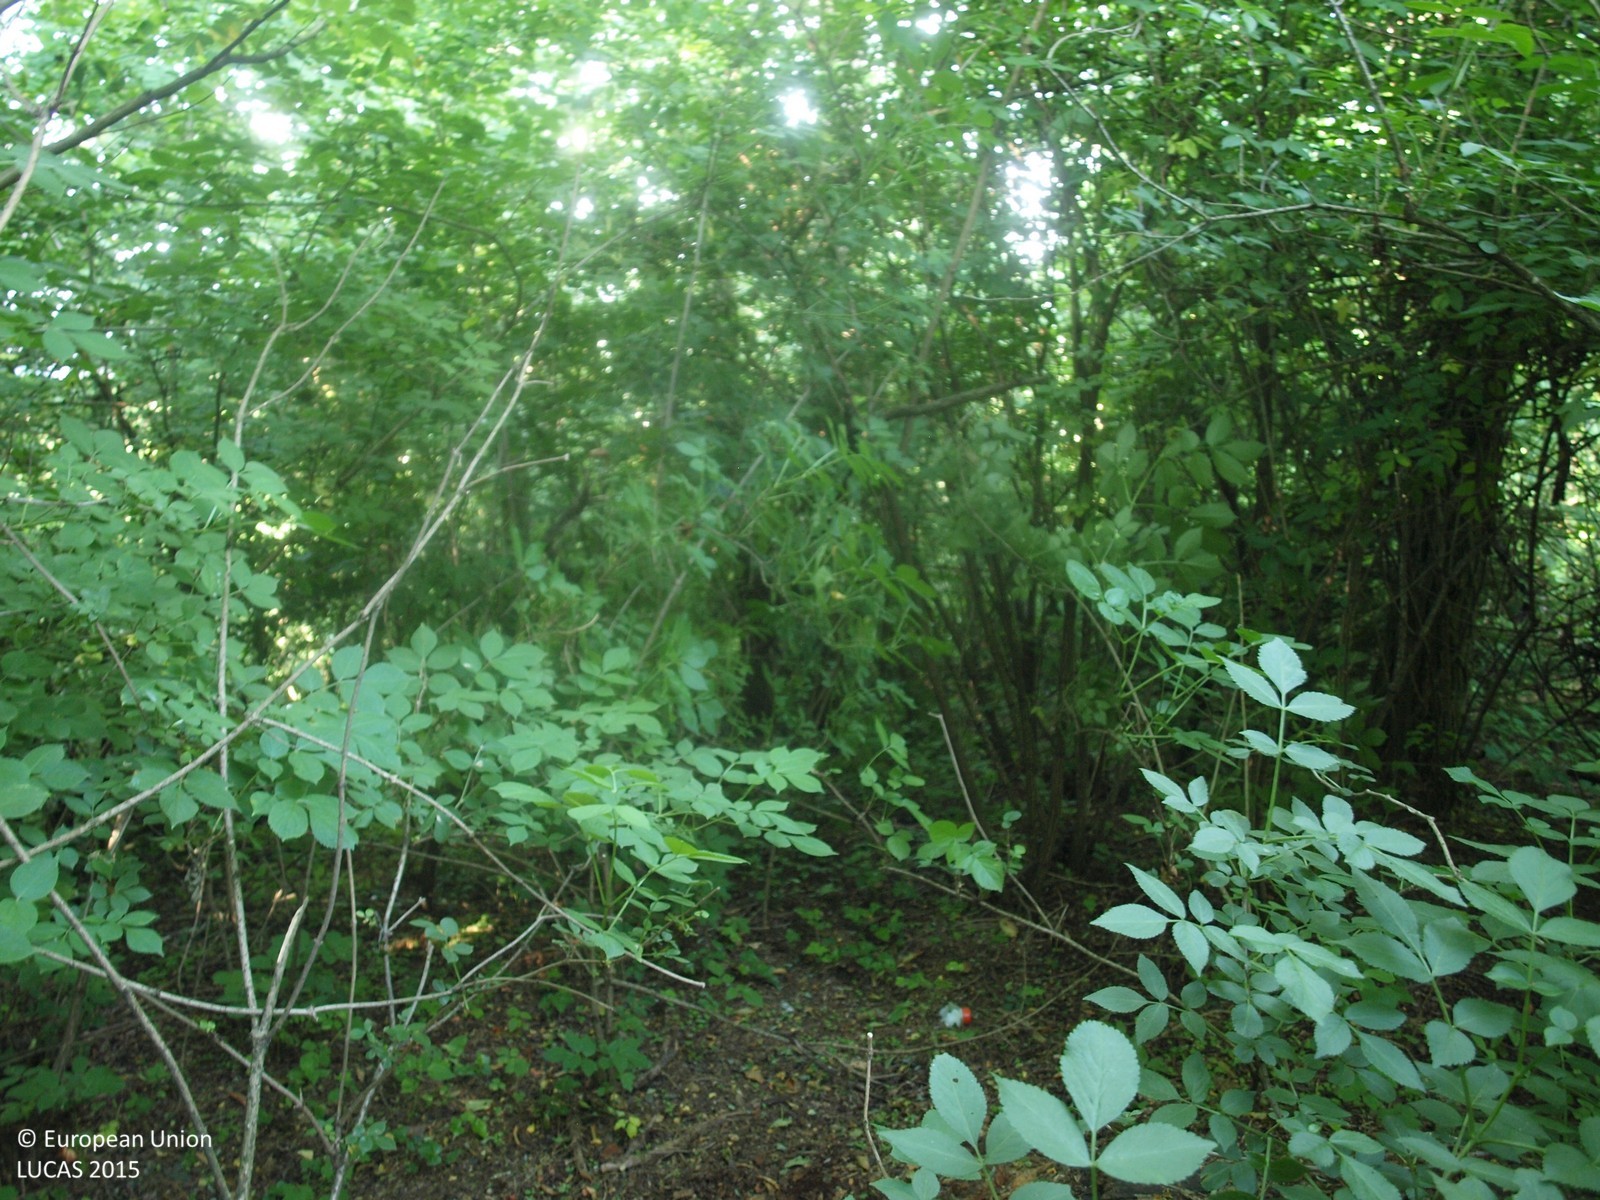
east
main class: Woodland
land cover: Broadleaved woodland
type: mesophytic deciduous forest
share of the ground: > 75 %
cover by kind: broadleaved forest trees 100 %
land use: Forestry
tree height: > 5 m
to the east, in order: Broadleaved woodland; Fences; Nuts trees; Fences; Artificial constructions in urban areas
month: June
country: HR
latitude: 46.2997
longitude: 16.1664
